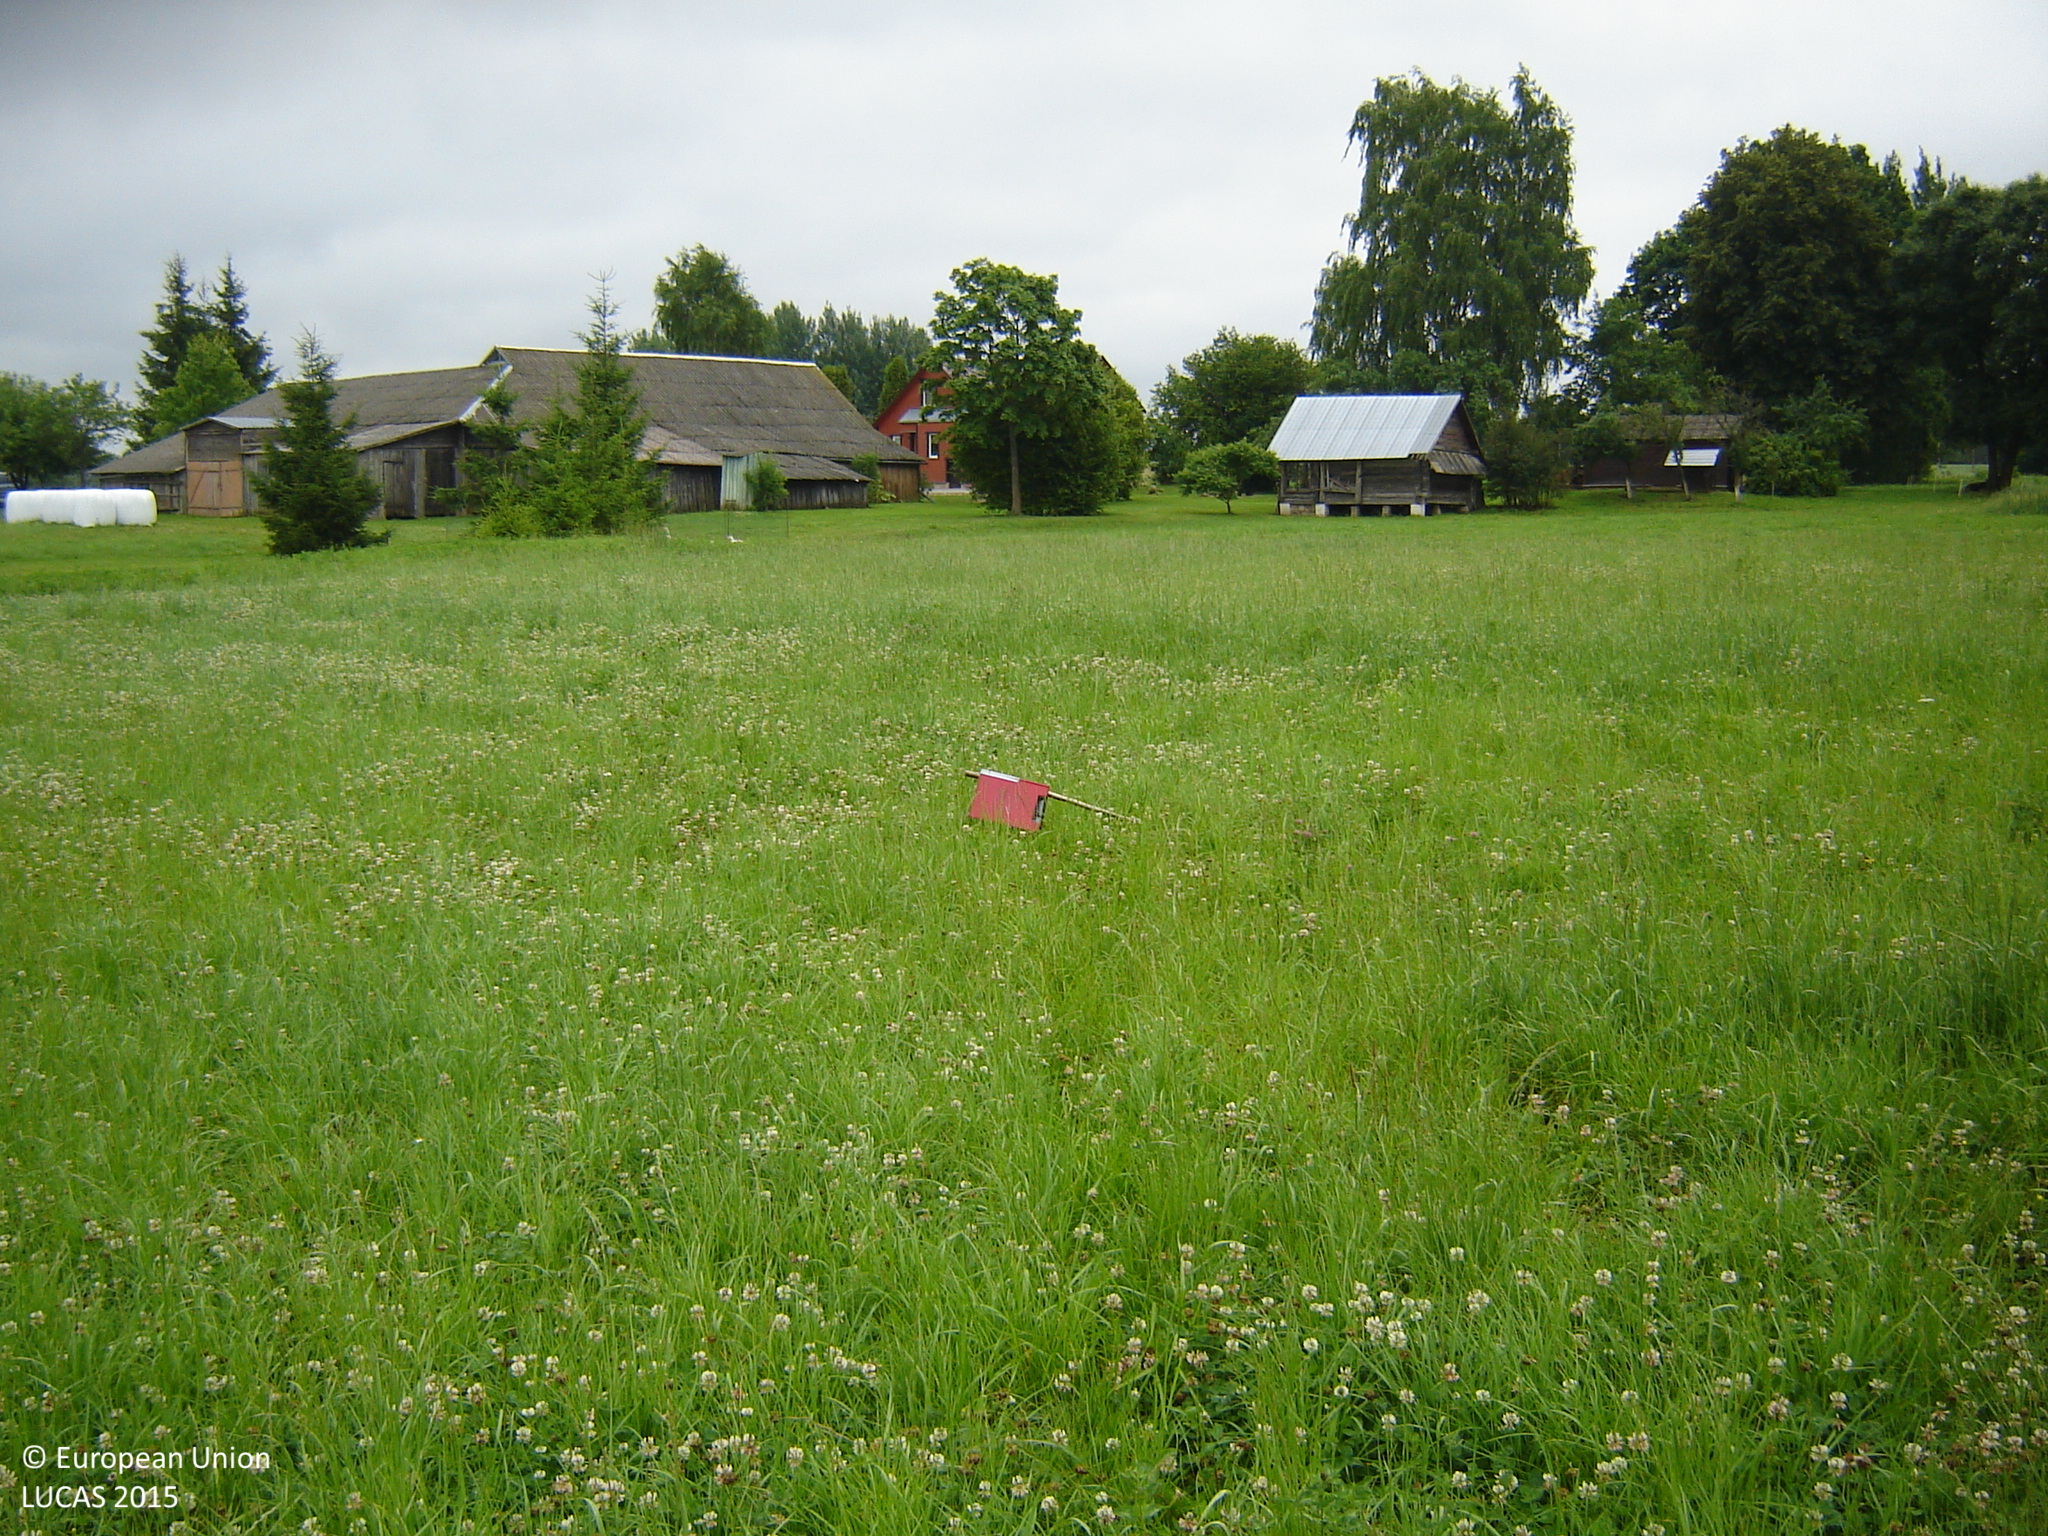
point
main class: Grassland
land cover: Grassland without tree/shrub cover
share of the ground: > 75 %
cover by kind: herbaceous plants 100 %
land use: Agriculture (excluding fallow land and kitchen gardens)
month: July
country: LT
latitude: 55.3467
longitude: 25.2088
